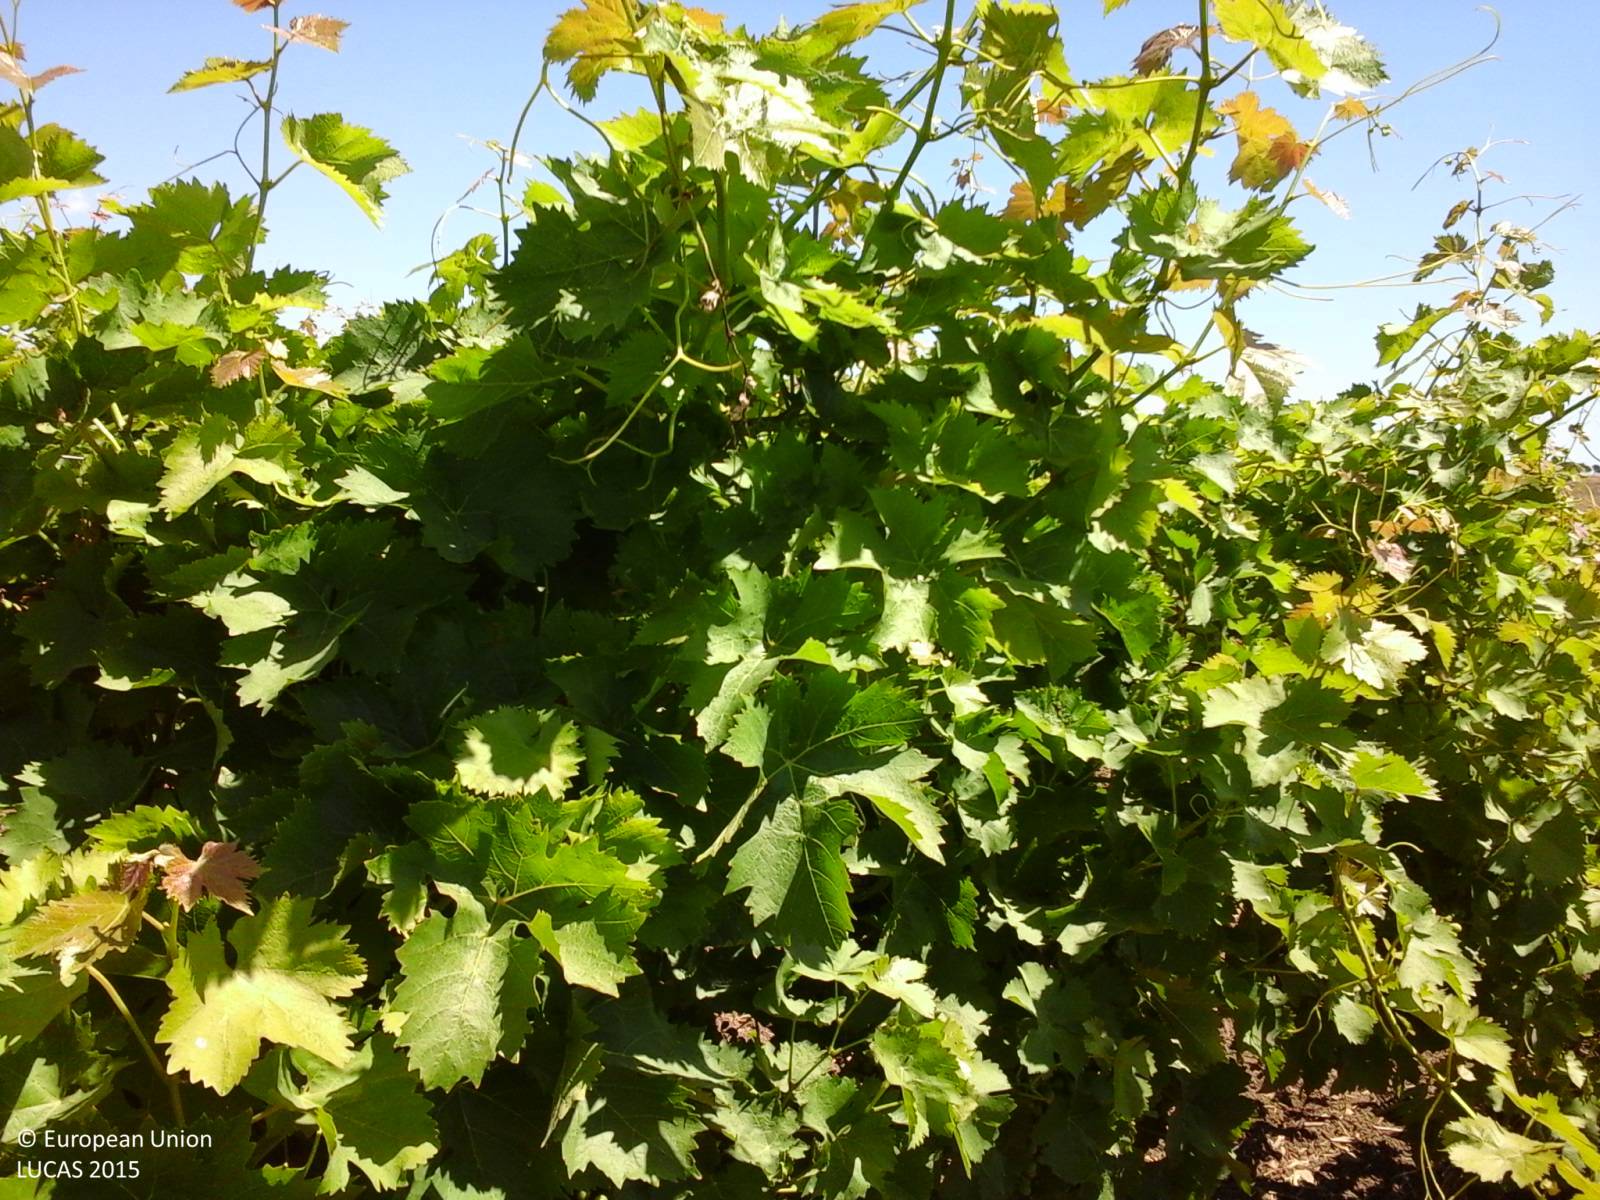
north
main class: Cropland
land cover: Vineyards
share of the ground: 50 - 75 %
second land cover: Other bare soil
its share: > 75 %
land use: Agriculture (excluding fallow land and kitchen gardens)
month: June
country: IT
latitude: 37.9971
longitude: 12.7925
